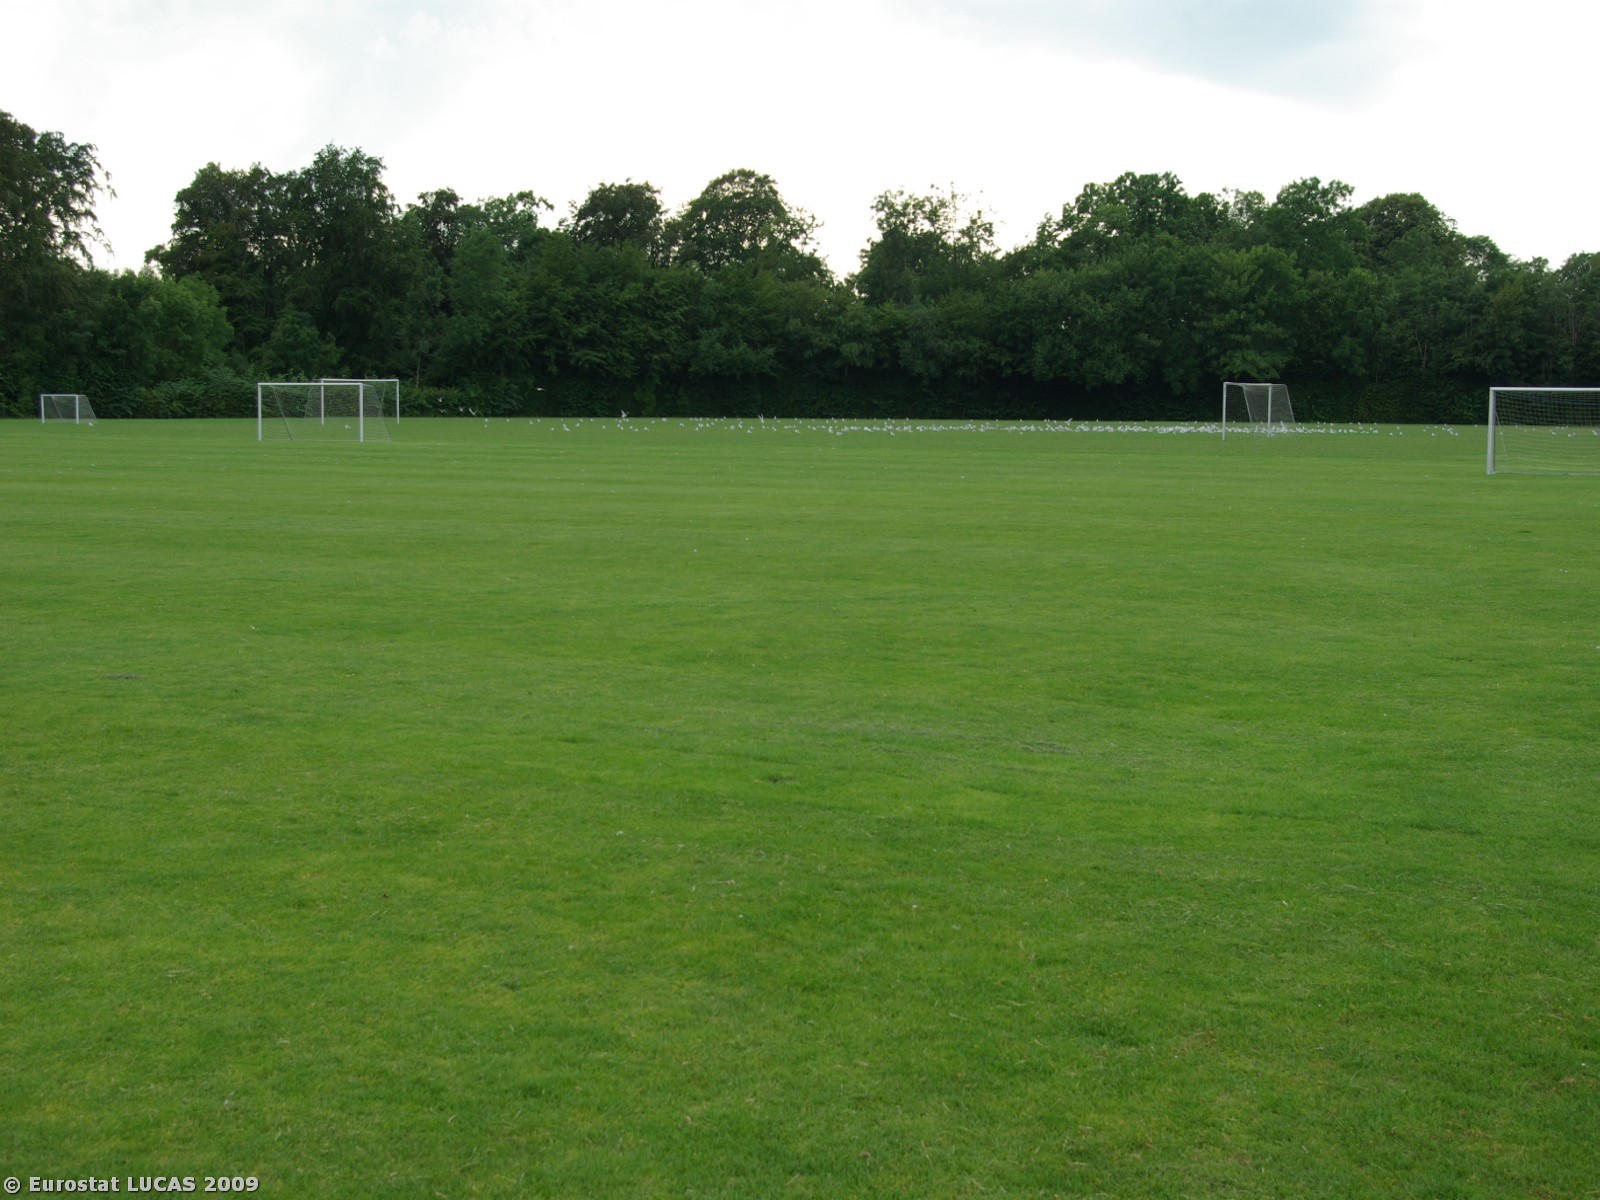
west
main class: Grassland
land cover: Grassland without tree/shrub cover
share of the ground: > 75 %
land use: Sport
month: July
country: DK
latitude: 55.0551
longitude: 9.7654
